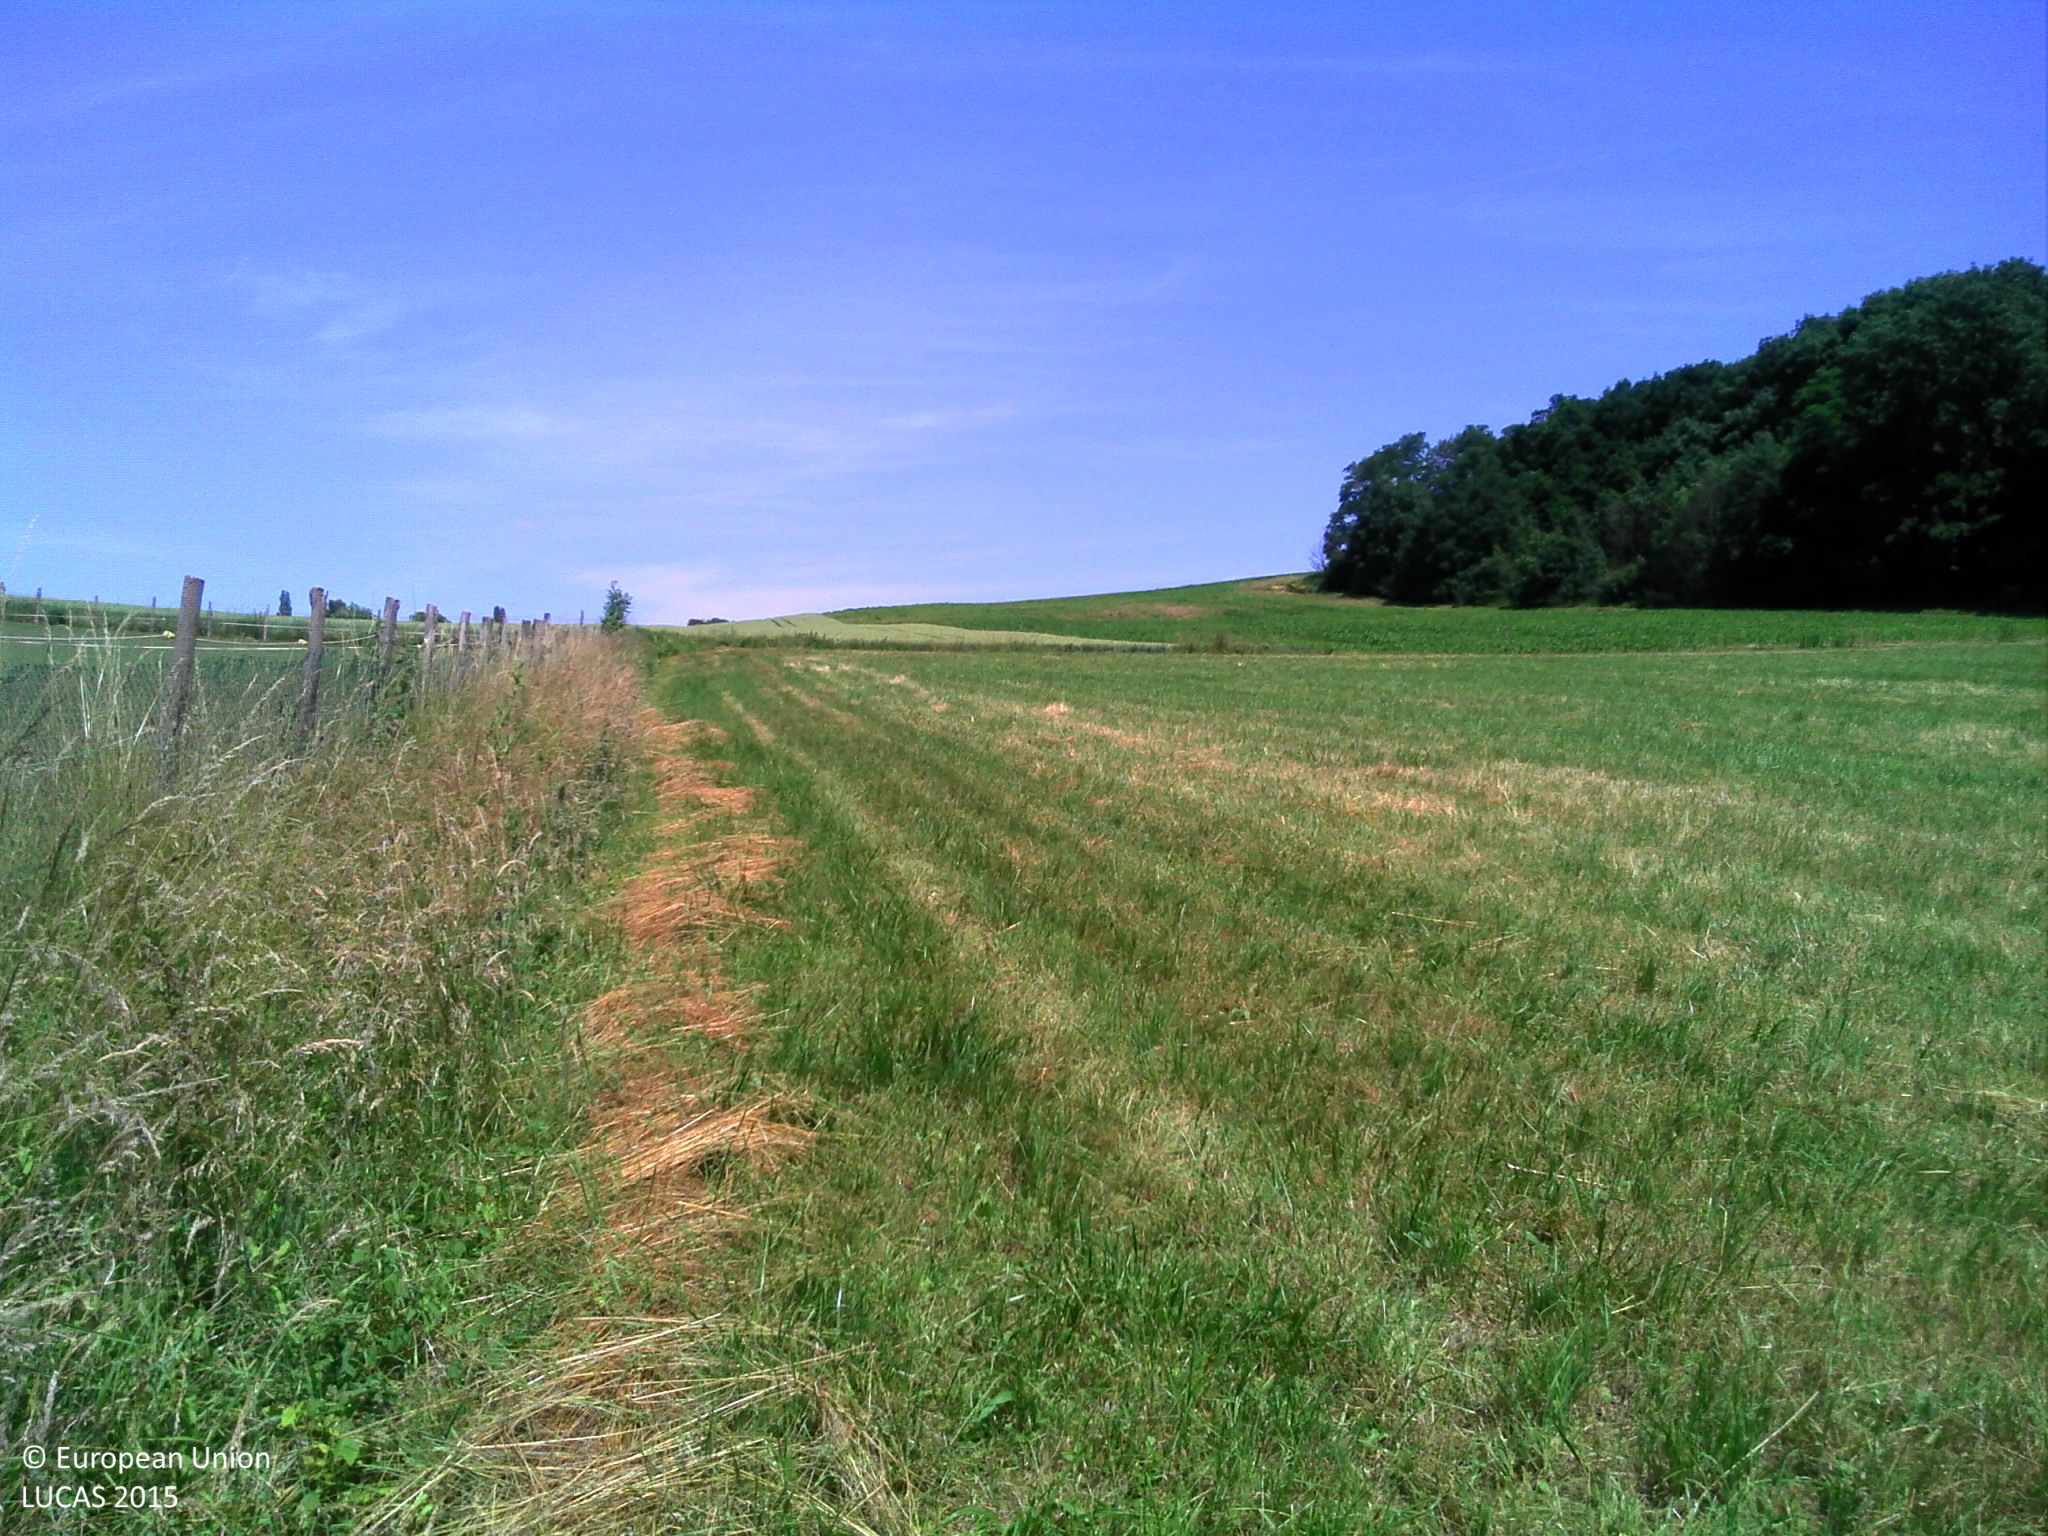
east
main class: Grassland
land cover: Grassland without tree/shrub cover
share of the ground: > 75 %
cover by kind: herbaceous plants 100 %
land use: Agriculture (excluding fallow land and kitchen gardens)
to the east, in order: Grassland without tree/shrub cover; Fences; Grassland without tree/shrub cover; Fences; Grassland without tree/shrub cover; Fences; Grass margins; Tracks; Grass margins; Common wheat; Maize
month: June
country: FR
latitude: 48.7193
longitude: 7.5949
